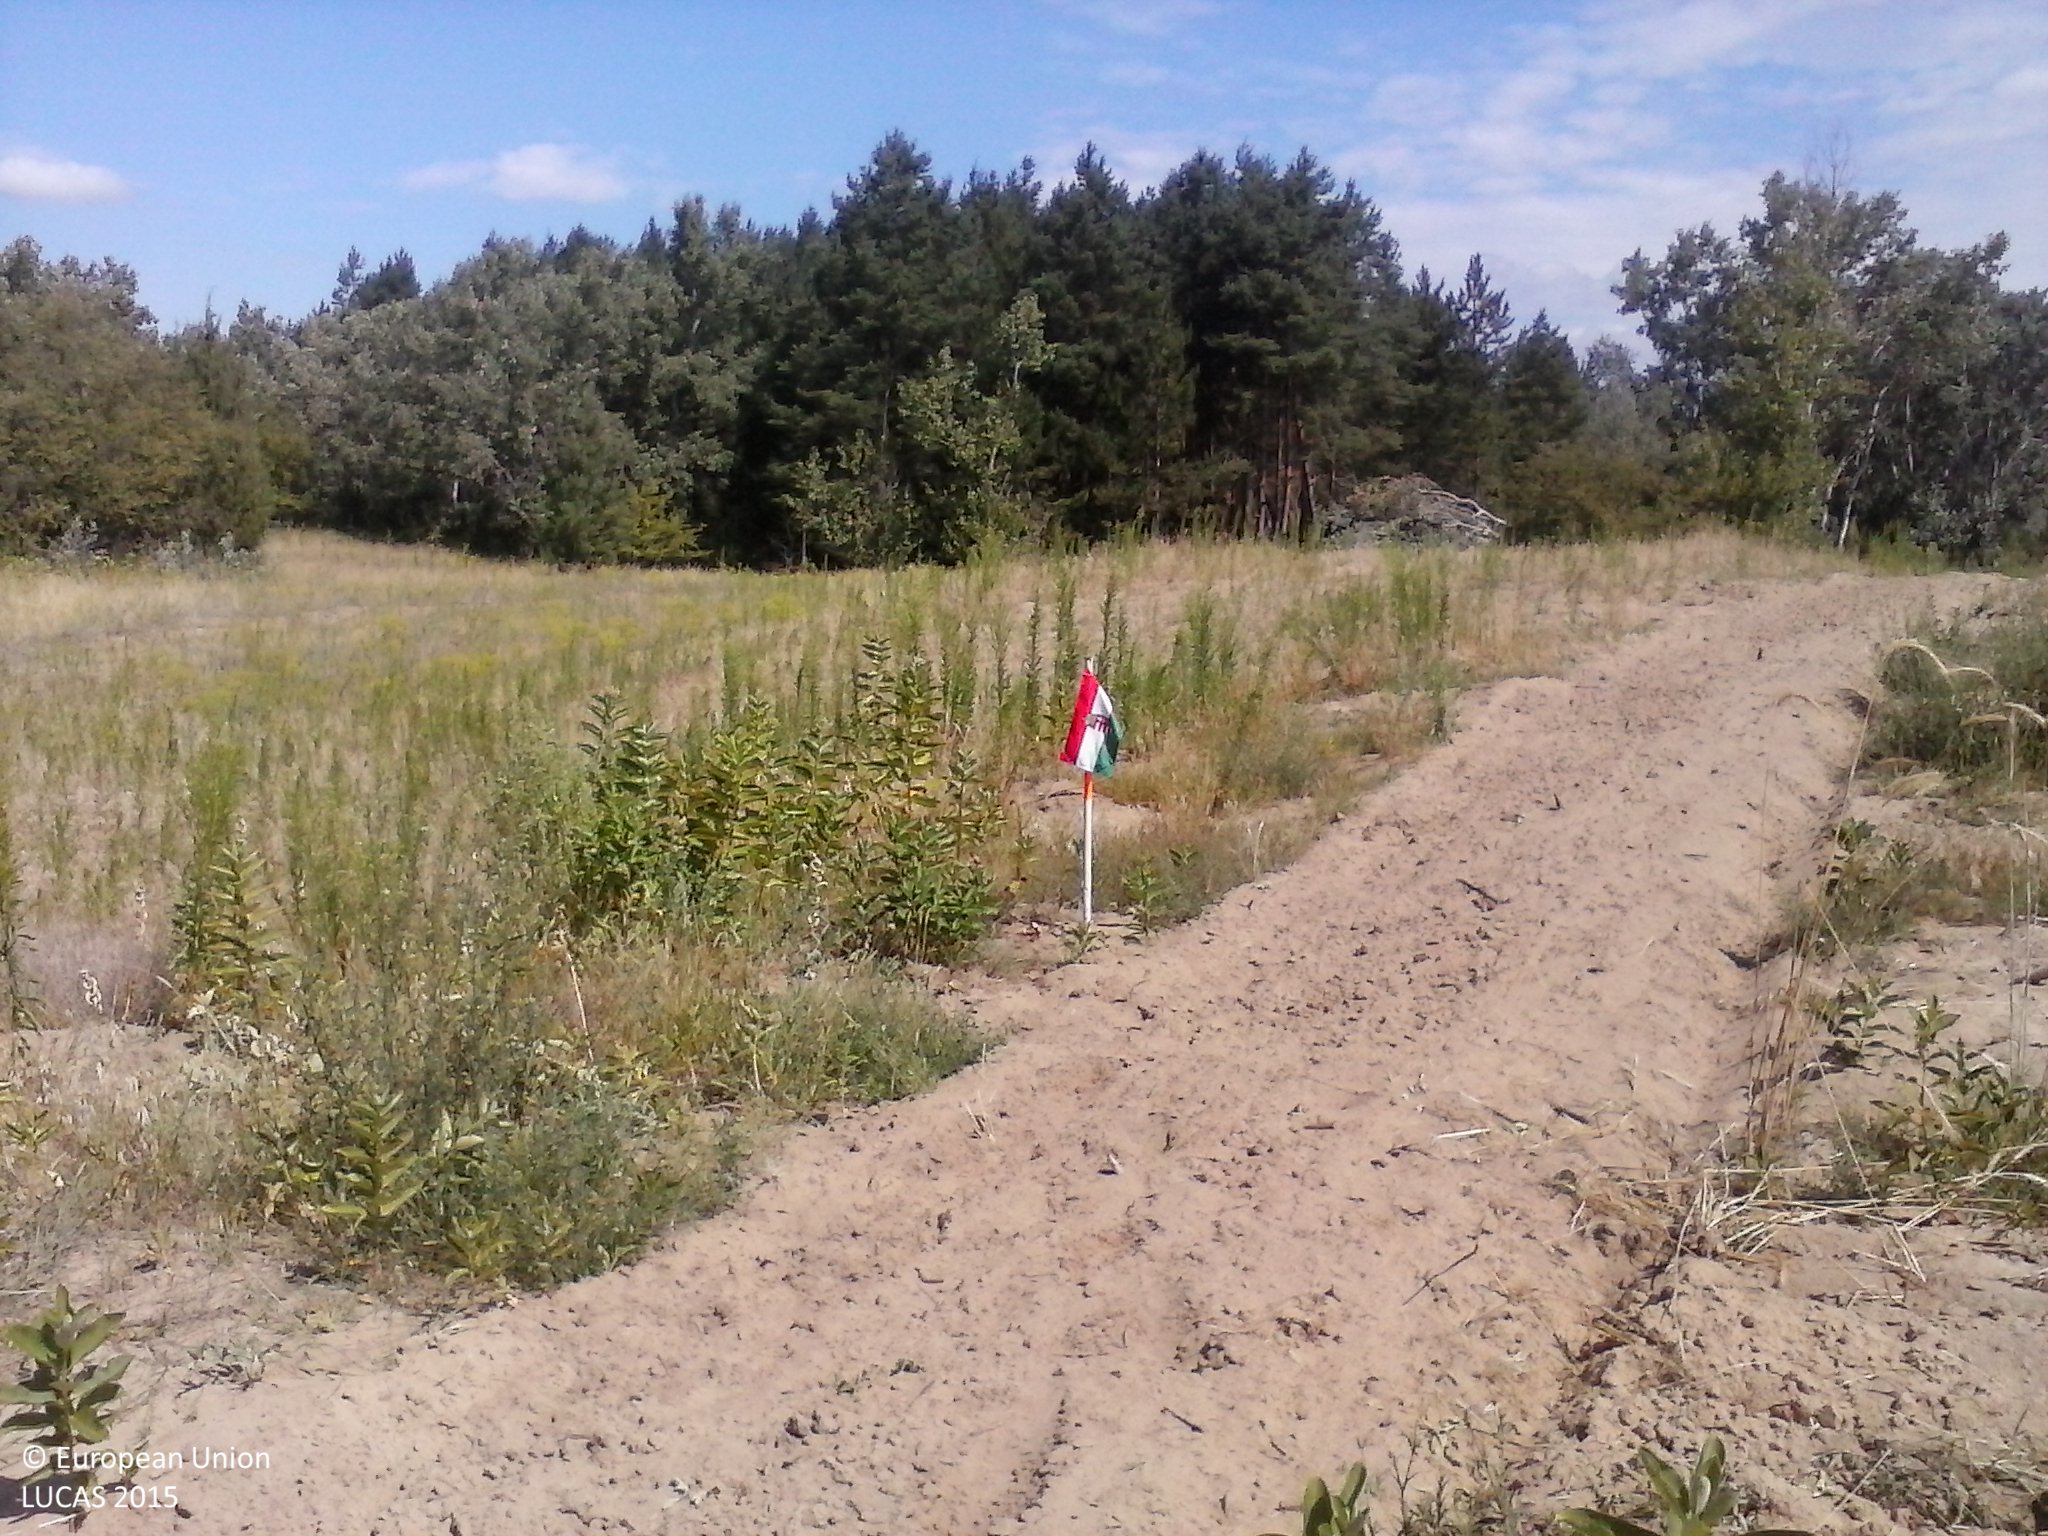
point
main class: Grassland
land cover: Spontaneously vegetated surfaces
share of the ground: 50 - 75 %
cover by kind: herbaceous plants 70 %, unconsolidated bare surface 25 %
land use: Forestry
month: July
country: HU
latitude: 46.5930
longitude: 19.5597
